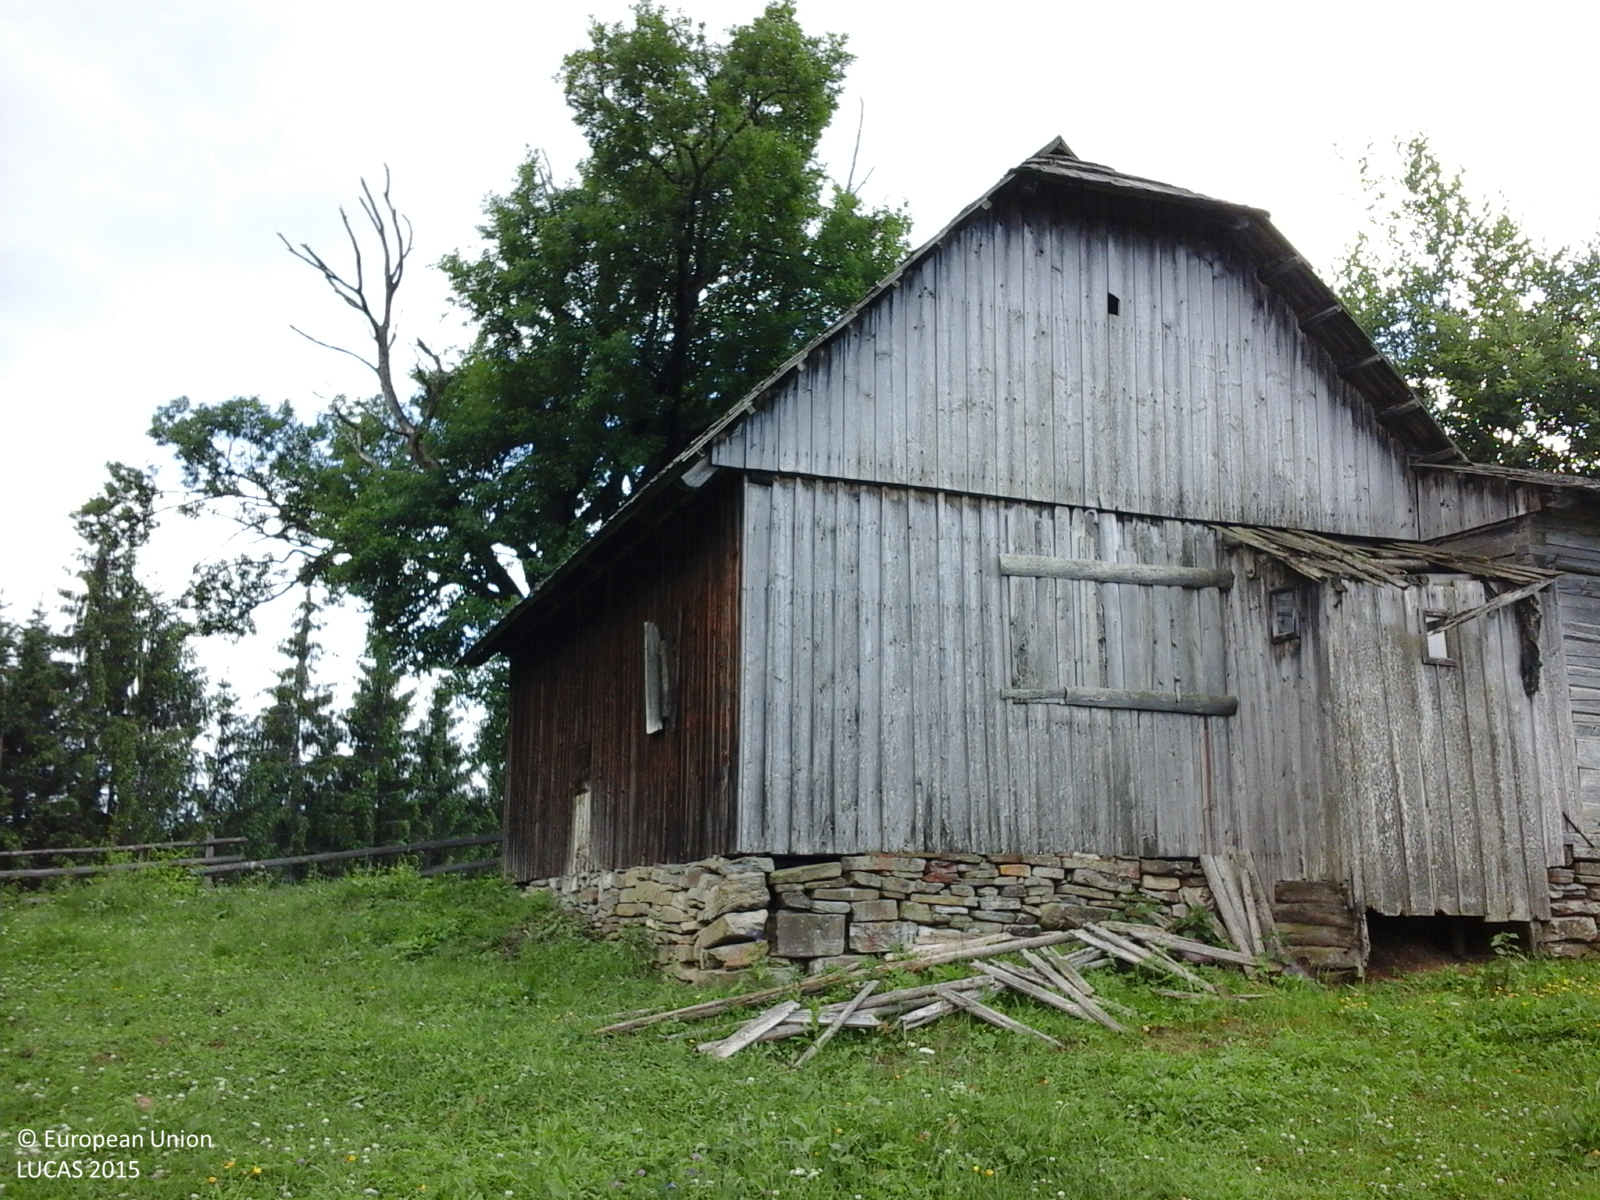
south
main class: Grassland
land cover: Grassland without tree/shrub cover
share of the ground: > 75 %
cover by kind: herbaceous plants 100 %
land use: Agriculture (excluding fallow land and kitchen gardens)
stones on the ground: < 10 %
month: June
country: RO
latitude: 47.8497
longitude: 25.2539
